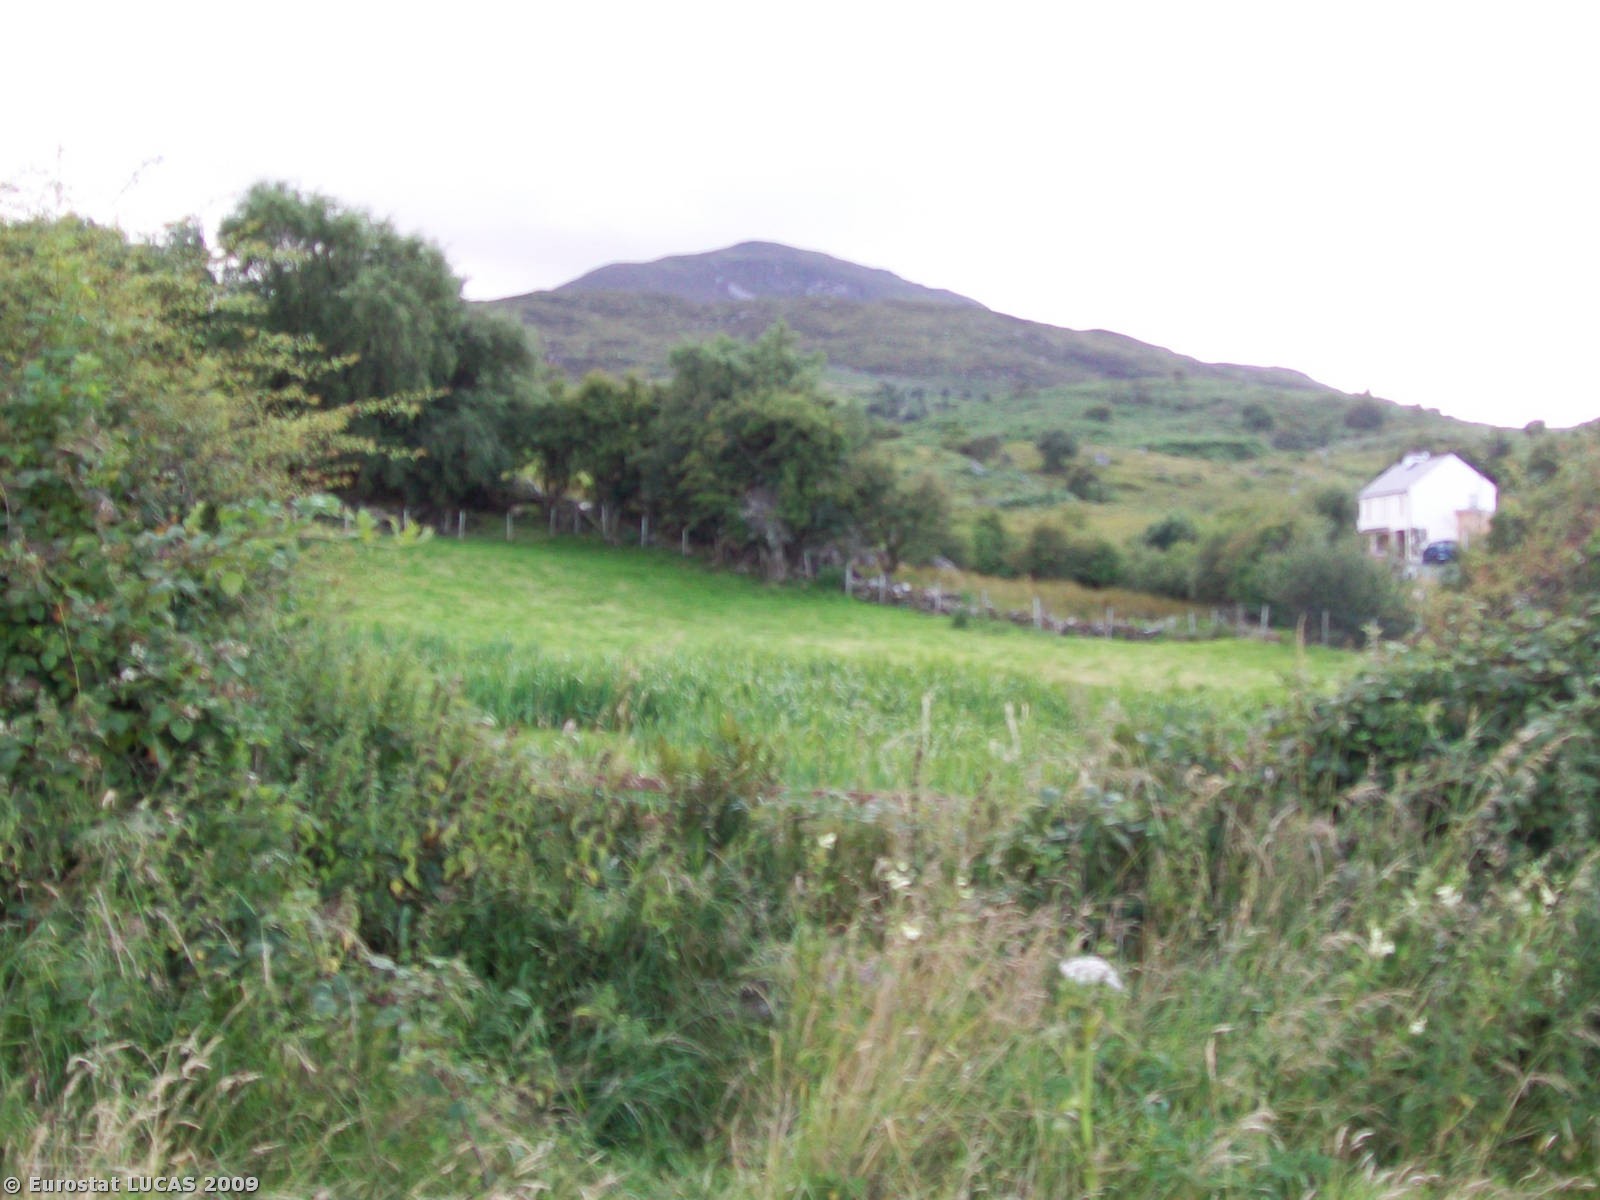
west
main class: Grassland
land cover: Grassland without tree/shrub cover
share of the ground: > 75 %
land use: Agriculture (excluding fallow land and kitchen gardens)
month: July
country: IE
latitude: 53.7643
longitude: -9.5772
